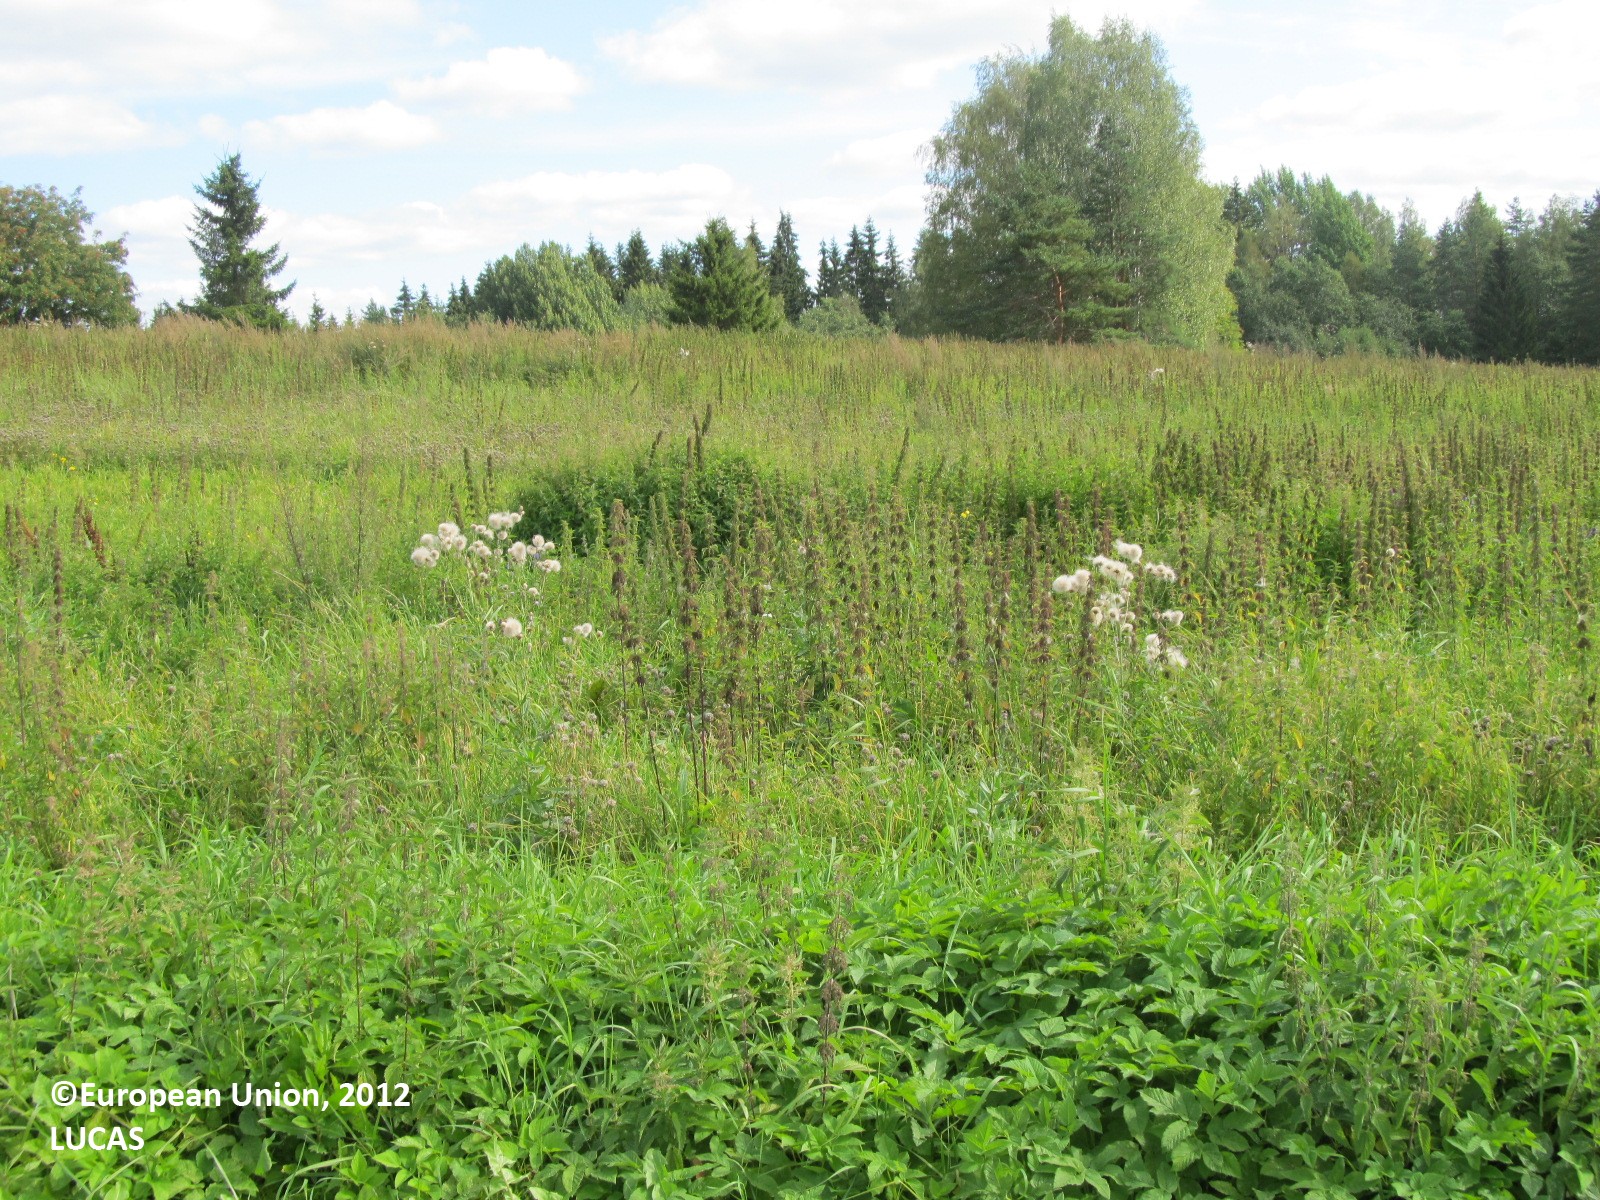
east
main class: Cropland
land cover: Other non-permanent industrial crops
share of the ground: 25 - 50 %
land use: Agriculture (excluding fallow land and kitchen gardens)
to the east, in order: Other non-permanent industrial crops; Grassland without tree/shrub cover; Fences; Dry stone walls; Grassland without tree/shrub cover; Dry stone walls; Grassland without tree/shrub cover; Fences; Dry stone walls; Grassland without tree/shrub cover; Lines of trees; Grassland without tree/shrub cover; Ditches and canals; Spontaneously vegetated surfaces
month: August
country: FI
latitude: 61.7631
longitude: 27.4726
